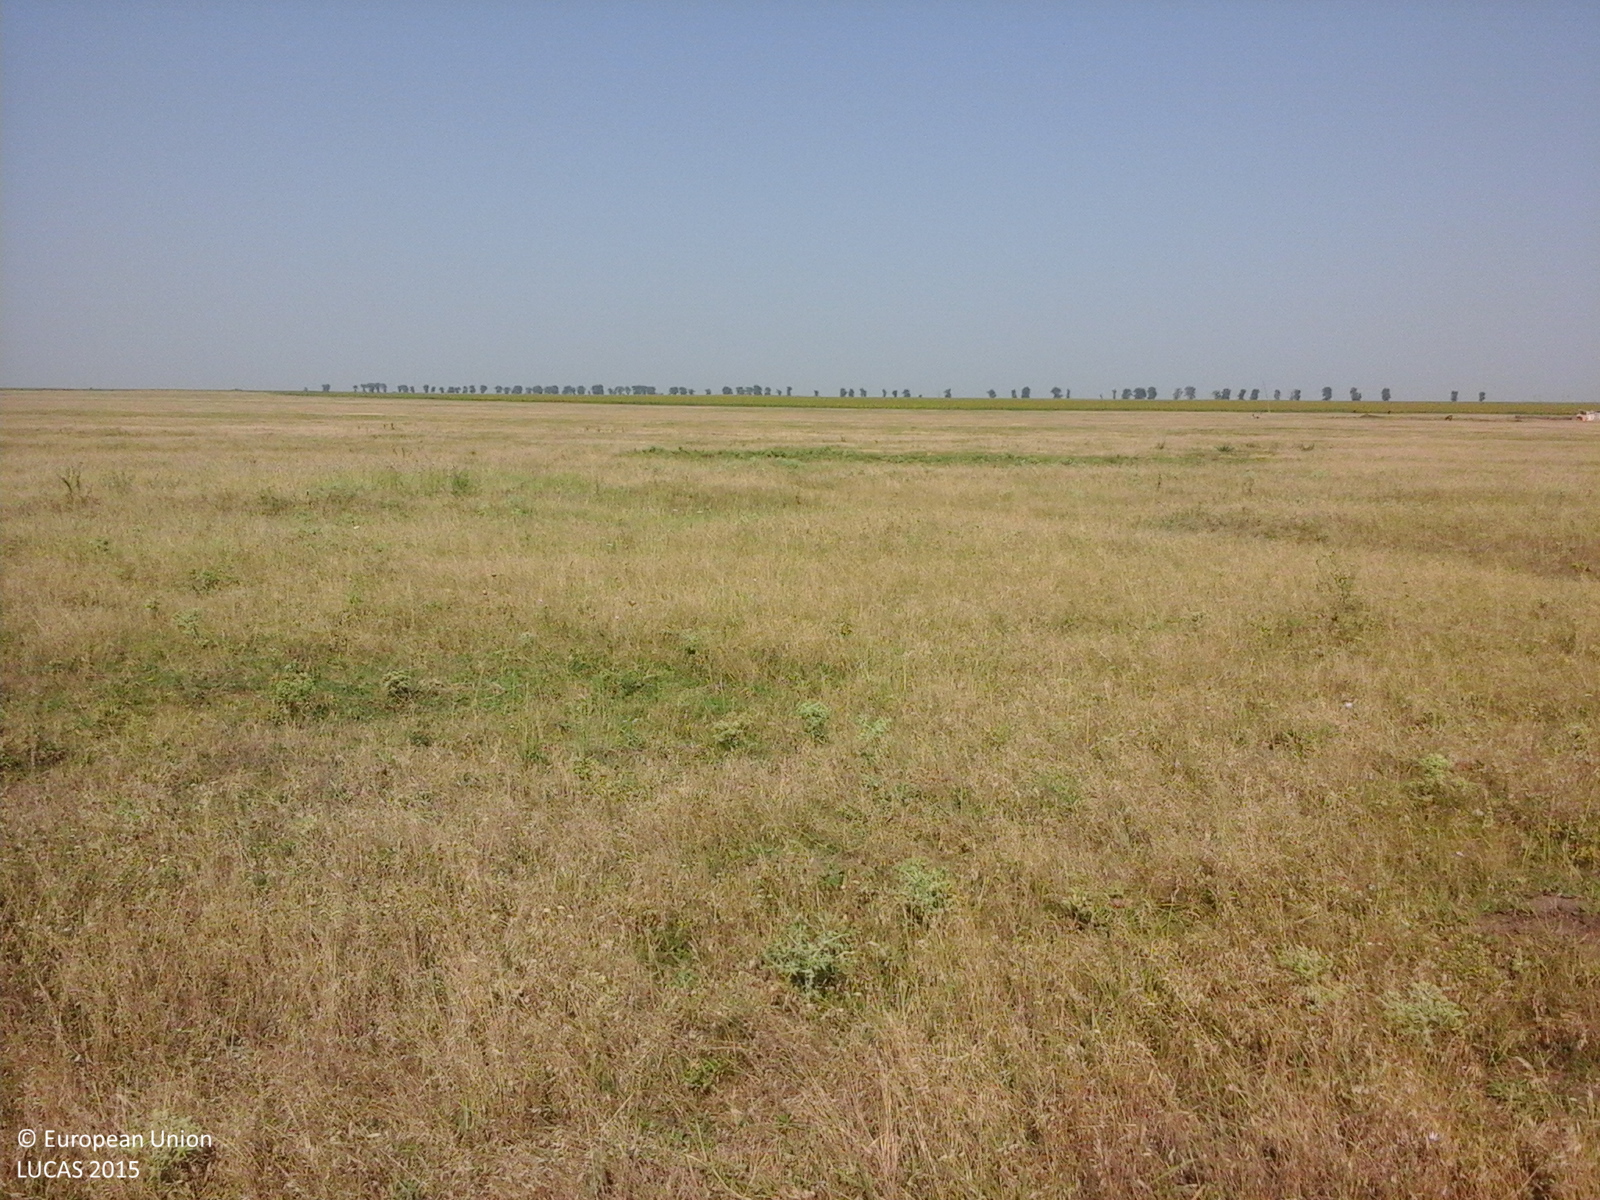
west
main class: Grassland
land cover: Grassland without tree/shrub cover
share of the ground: > 75 %
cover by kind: herbaceous plants 100 %
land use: Agriculture (excluding fallow land and kitchen gardens)
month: July
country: RO
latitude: 44.8129
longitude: 27.3256
